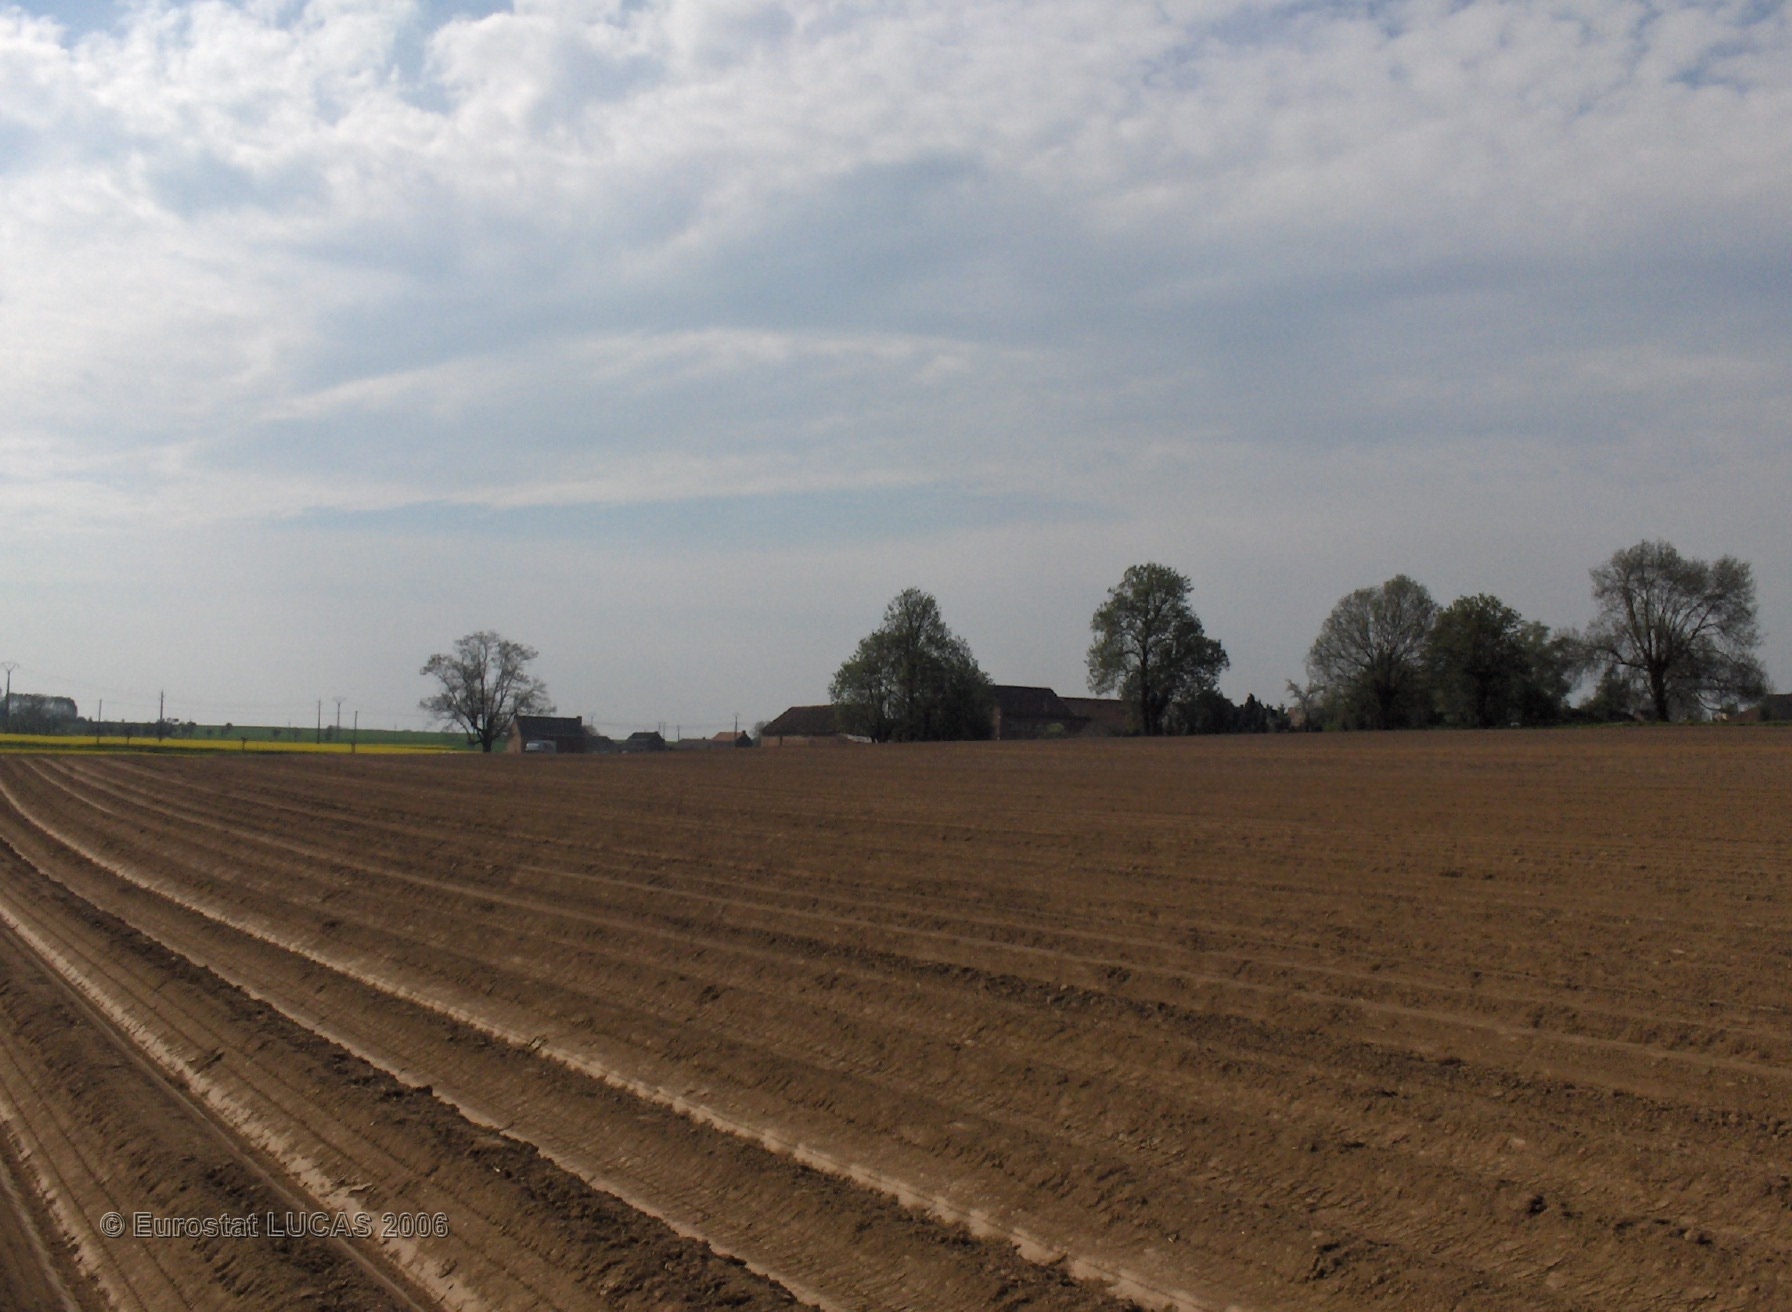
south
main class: Cropland
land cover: Potatoes
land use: Agriculture (excluding fallow land and kitchen gardens)
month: May
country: BE
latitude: 50.6609
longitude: 5.2302
